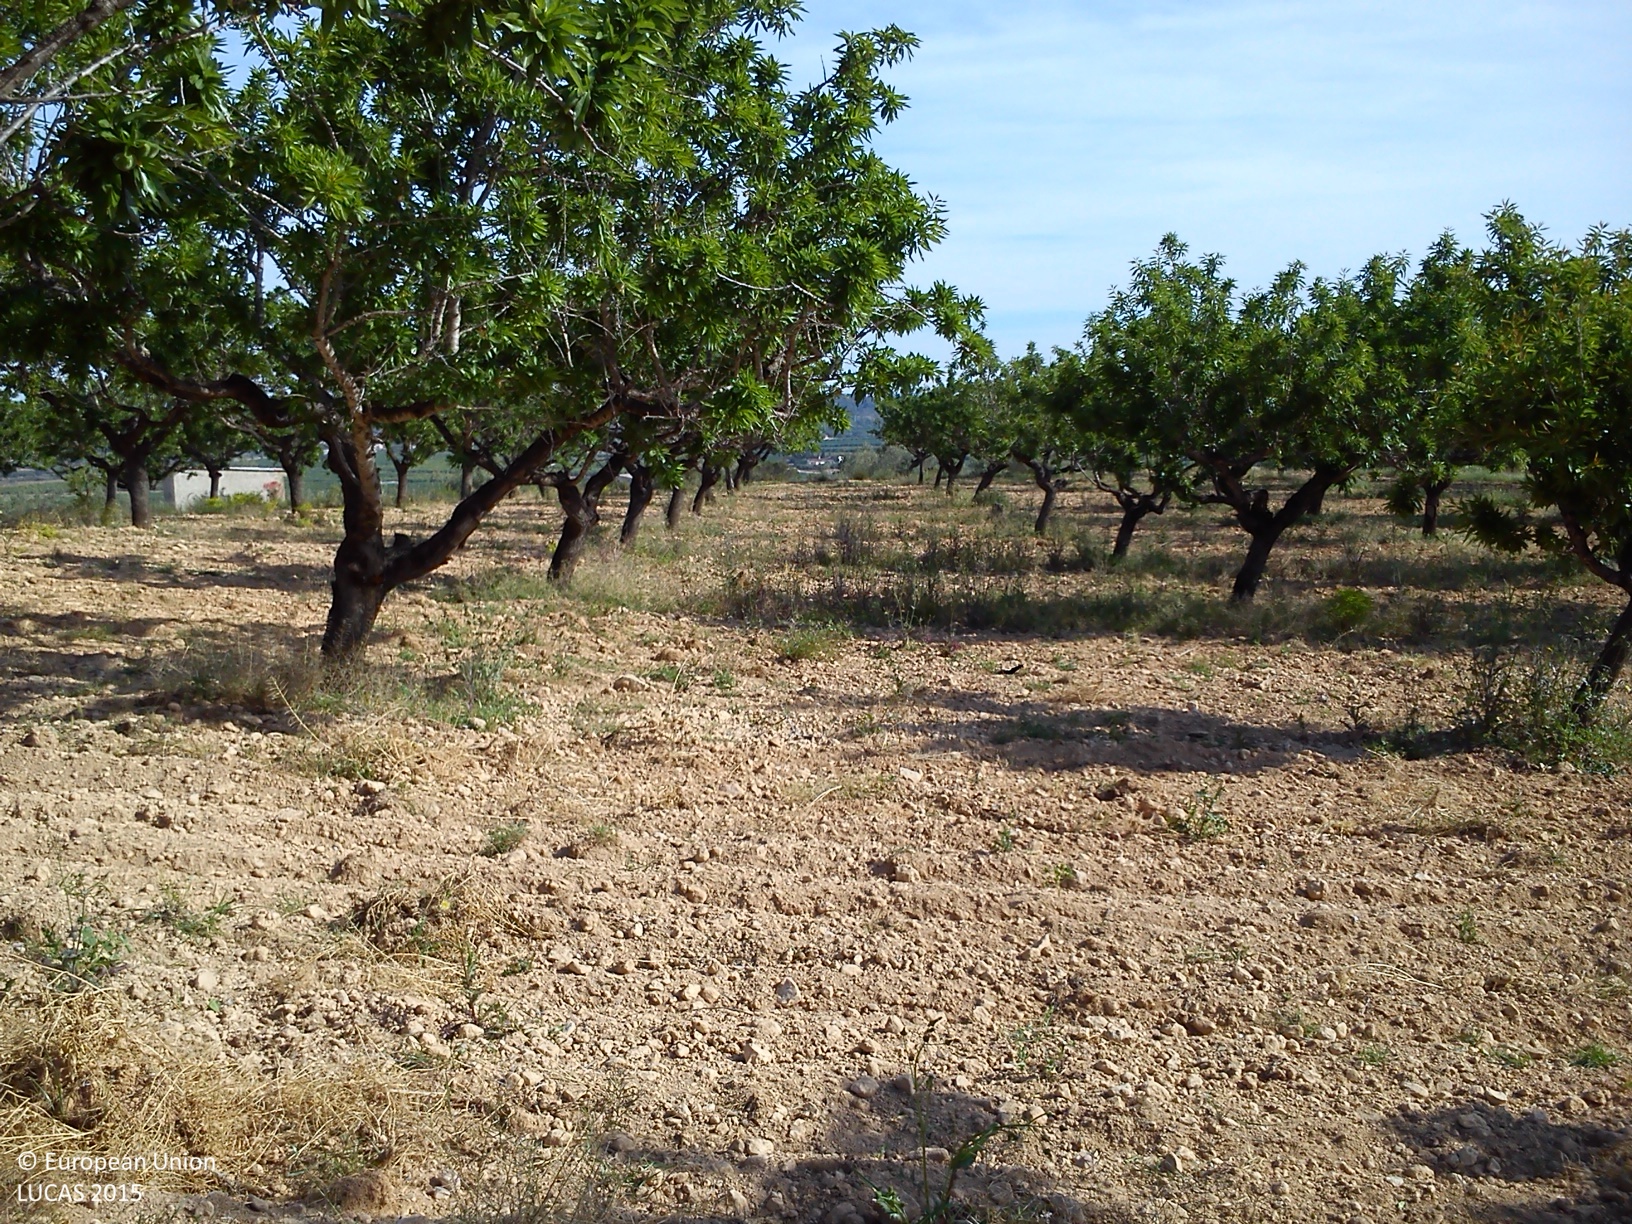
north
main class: Cropland
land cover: Nuts trees
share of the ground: 25 - 50 %
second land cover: Spontaneously vegetated surfaces
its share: < 10 %
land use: Agriculture (excluding fallow land and kitchen gardens)
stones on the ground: 25 - 50 %
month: April
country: ES
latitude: 39.5558
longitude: -0.6719
